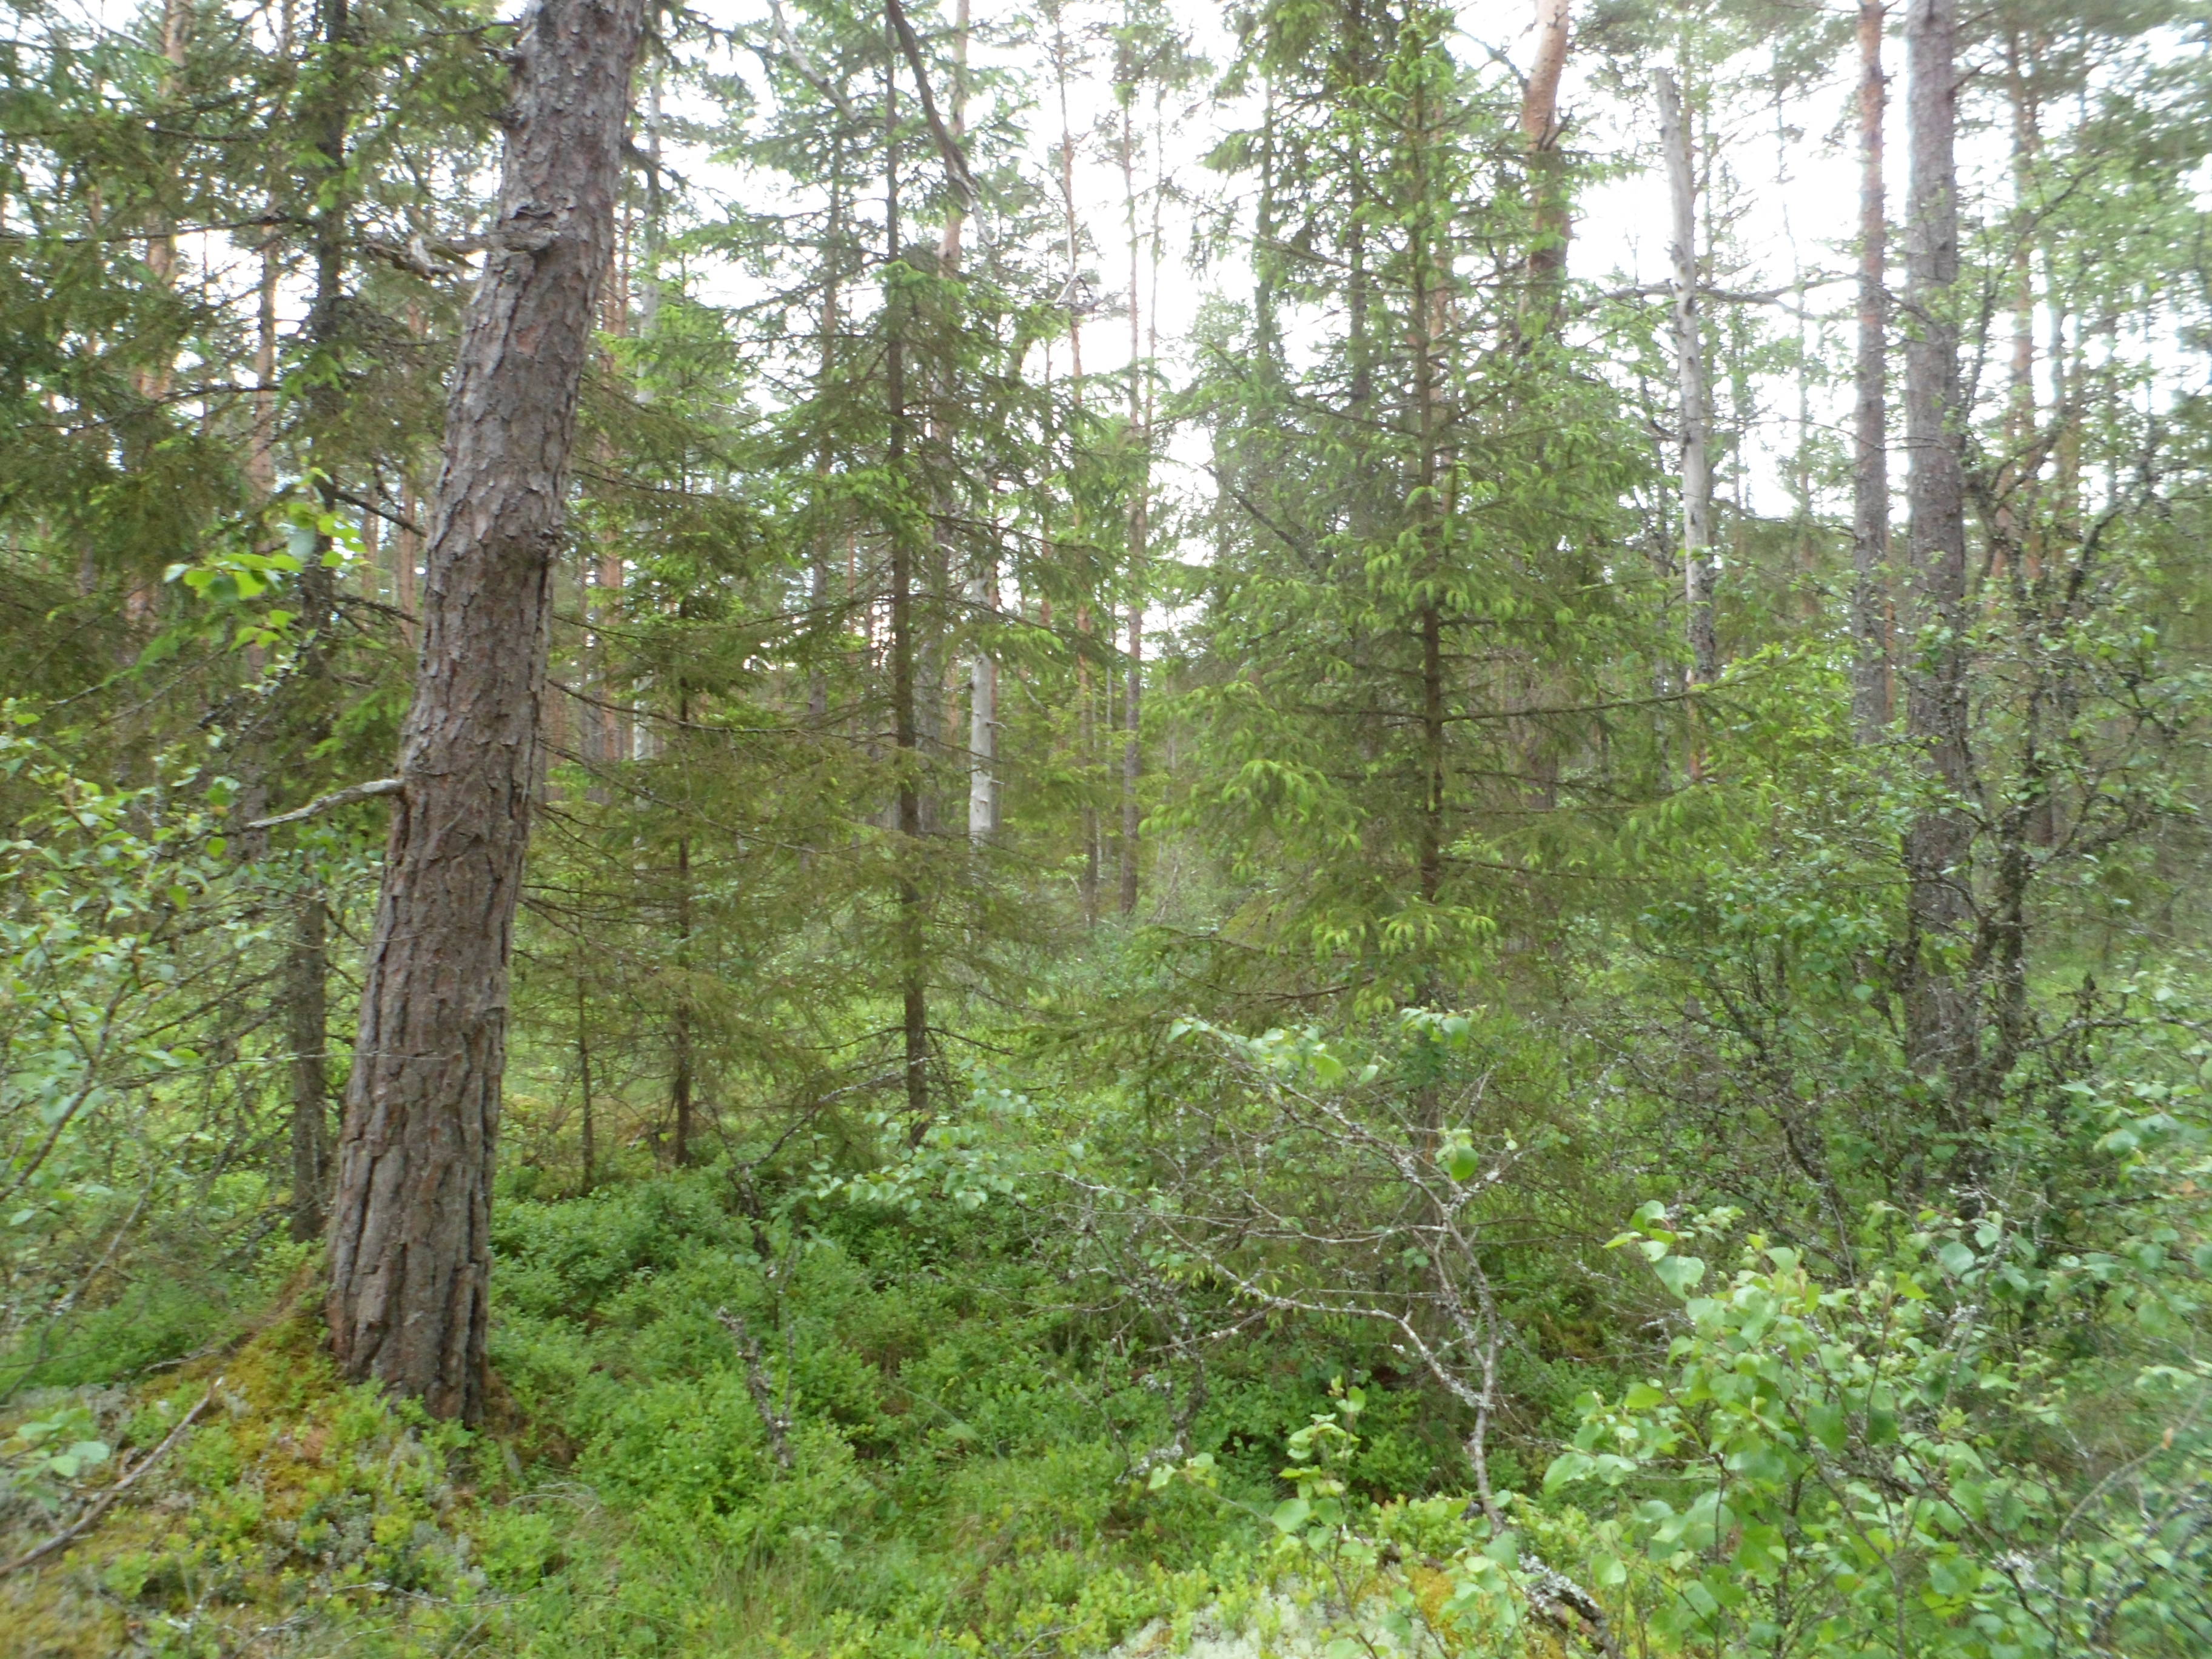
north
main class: Woodland
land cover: Pine dominated mixed woodland
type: boreal forest
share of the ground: 50 - 75 %
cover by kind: coniferous forest trees 40 %, shrubs 20 %, lichens and mosses 20 %, broadleaved forest trees 15 %, herbaceous plants 5 %
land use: Forestry
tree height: > 5 m
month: June
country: SE
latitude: 56.9086
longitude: 14.2829
